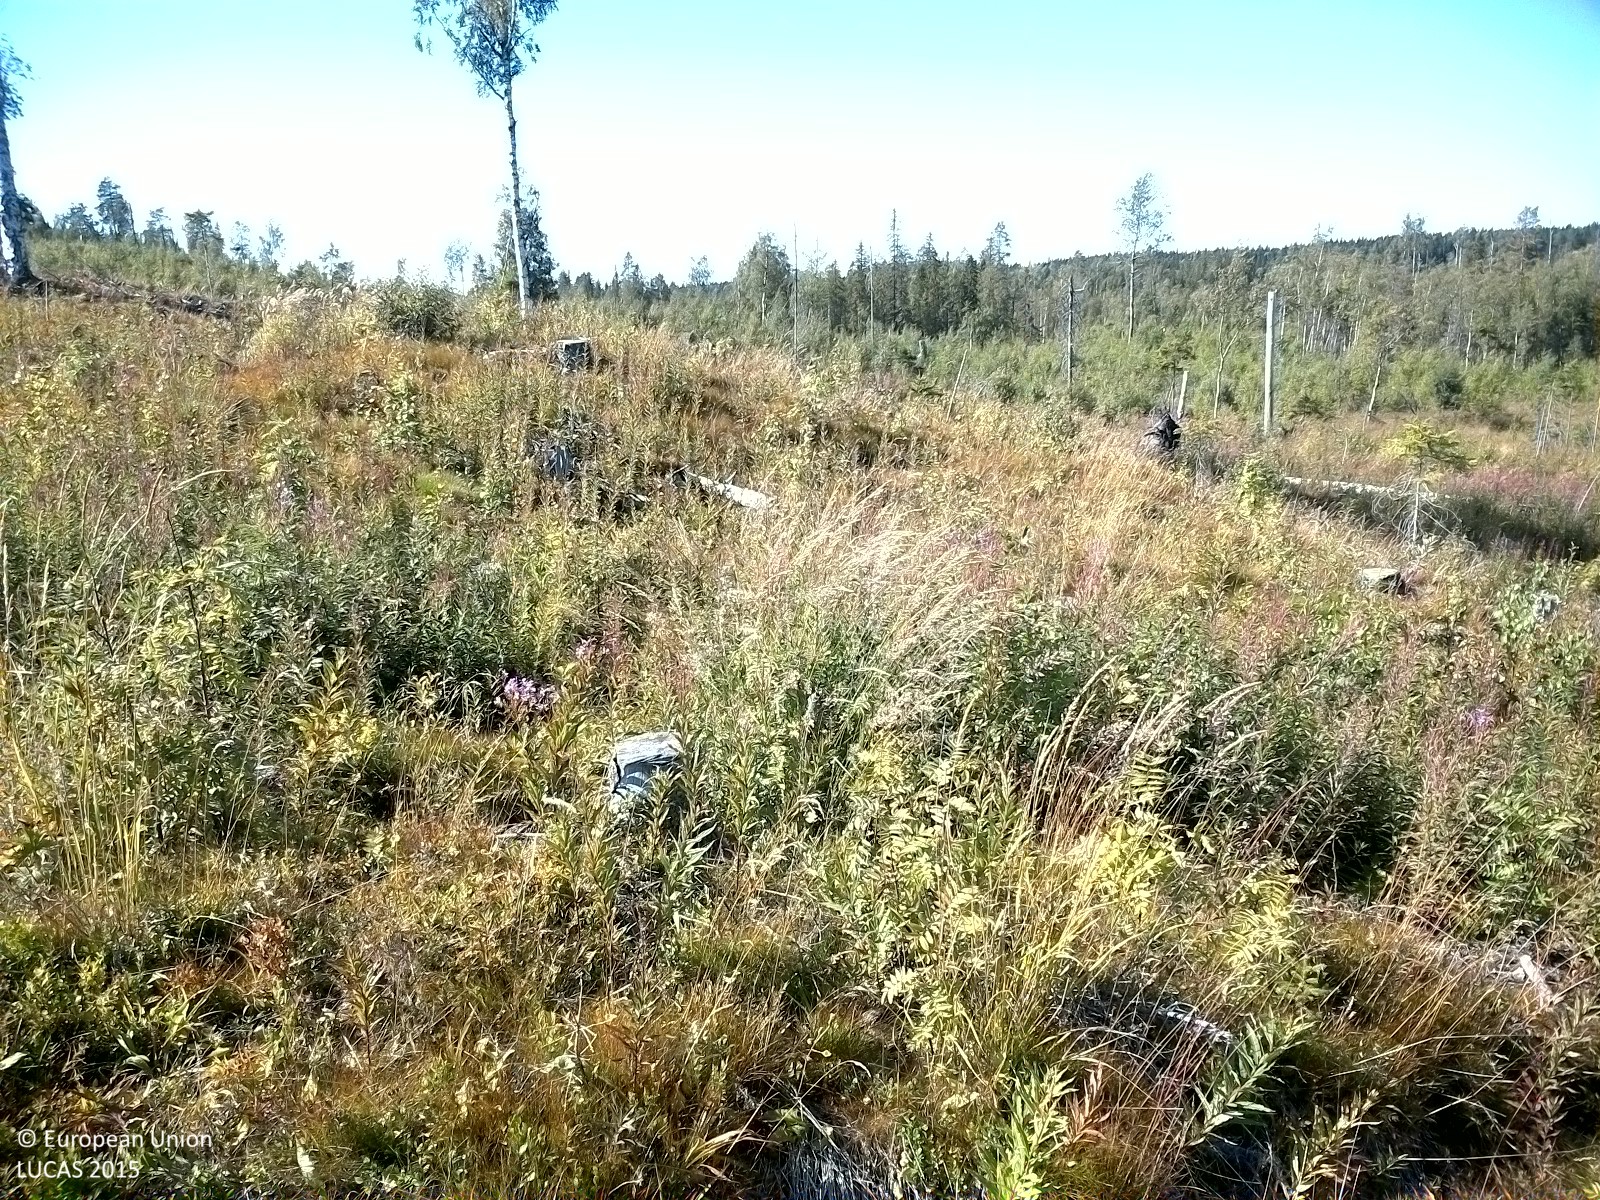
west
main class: Woodland
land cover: Spruce dominated mixed woodland
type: boreal forest
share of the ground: 10 - 25 %
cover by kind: herbaceous plants 85 %, broadleaved forest trees 10 %, coniferous forest trees 5 %
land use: Forestry
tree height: < 5 m
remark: Clear cut
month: August
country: SE
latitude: 62.4415
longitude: 16.7801
